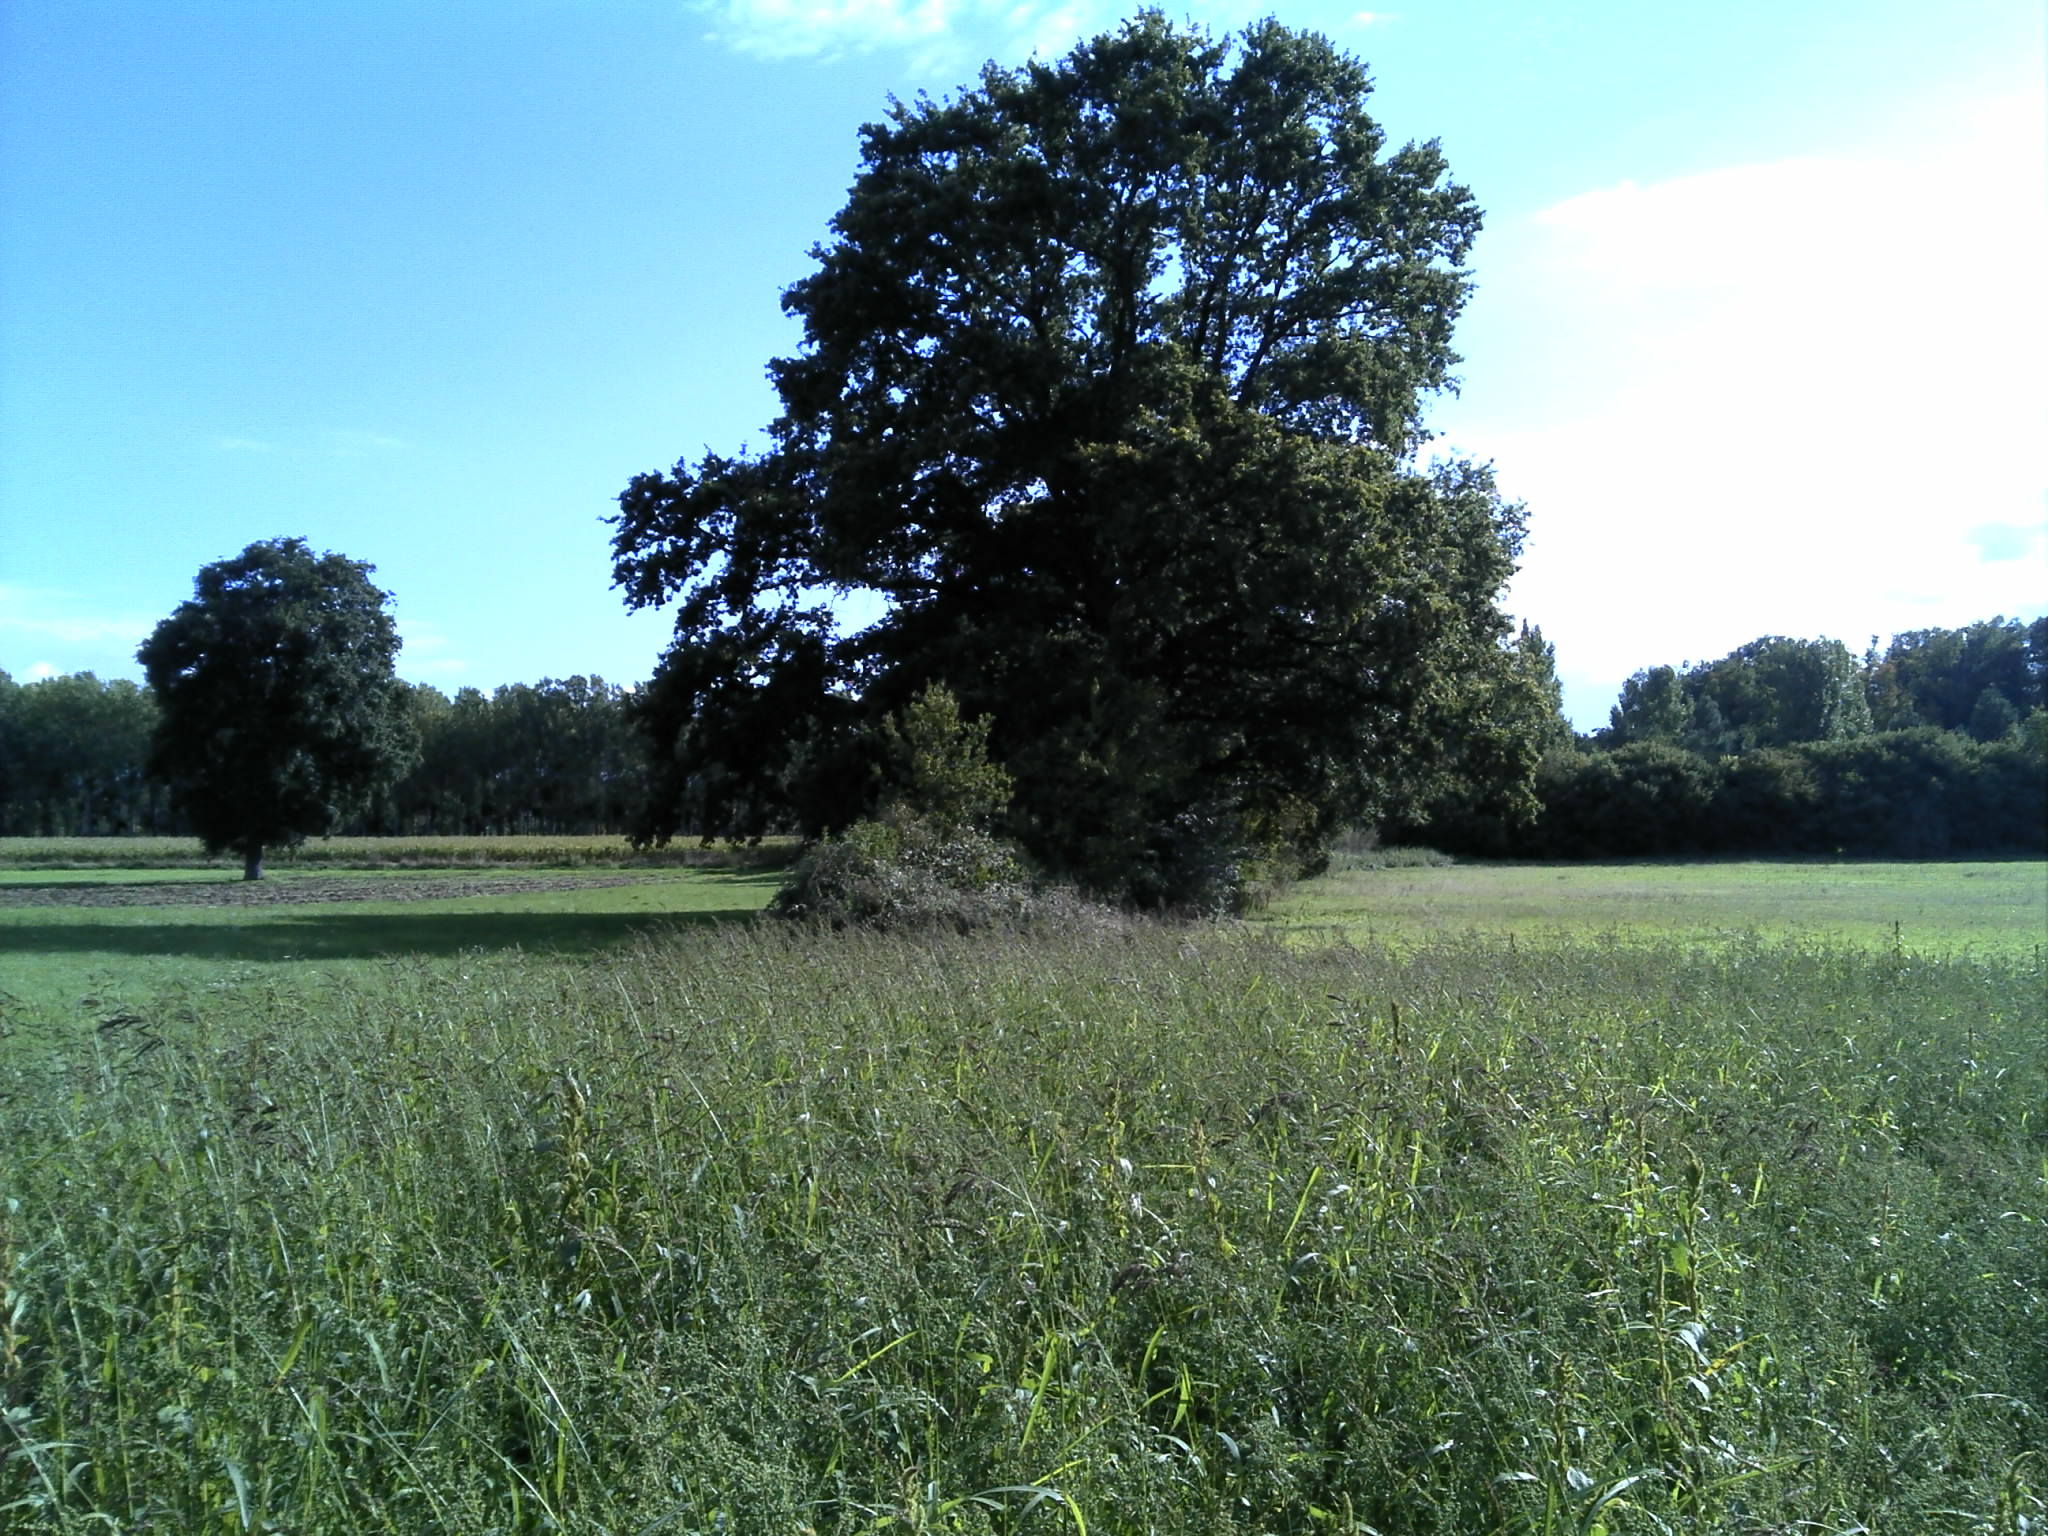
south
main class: Grassland
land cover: Spontaneously vegetated surfaces
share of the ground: > 75 %
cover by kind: herbaceous plants 100 %
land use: Agriculture (excluding fallow land and kitchen gardens)
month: September
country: FR
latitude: 47.7209
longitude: 0.2841
